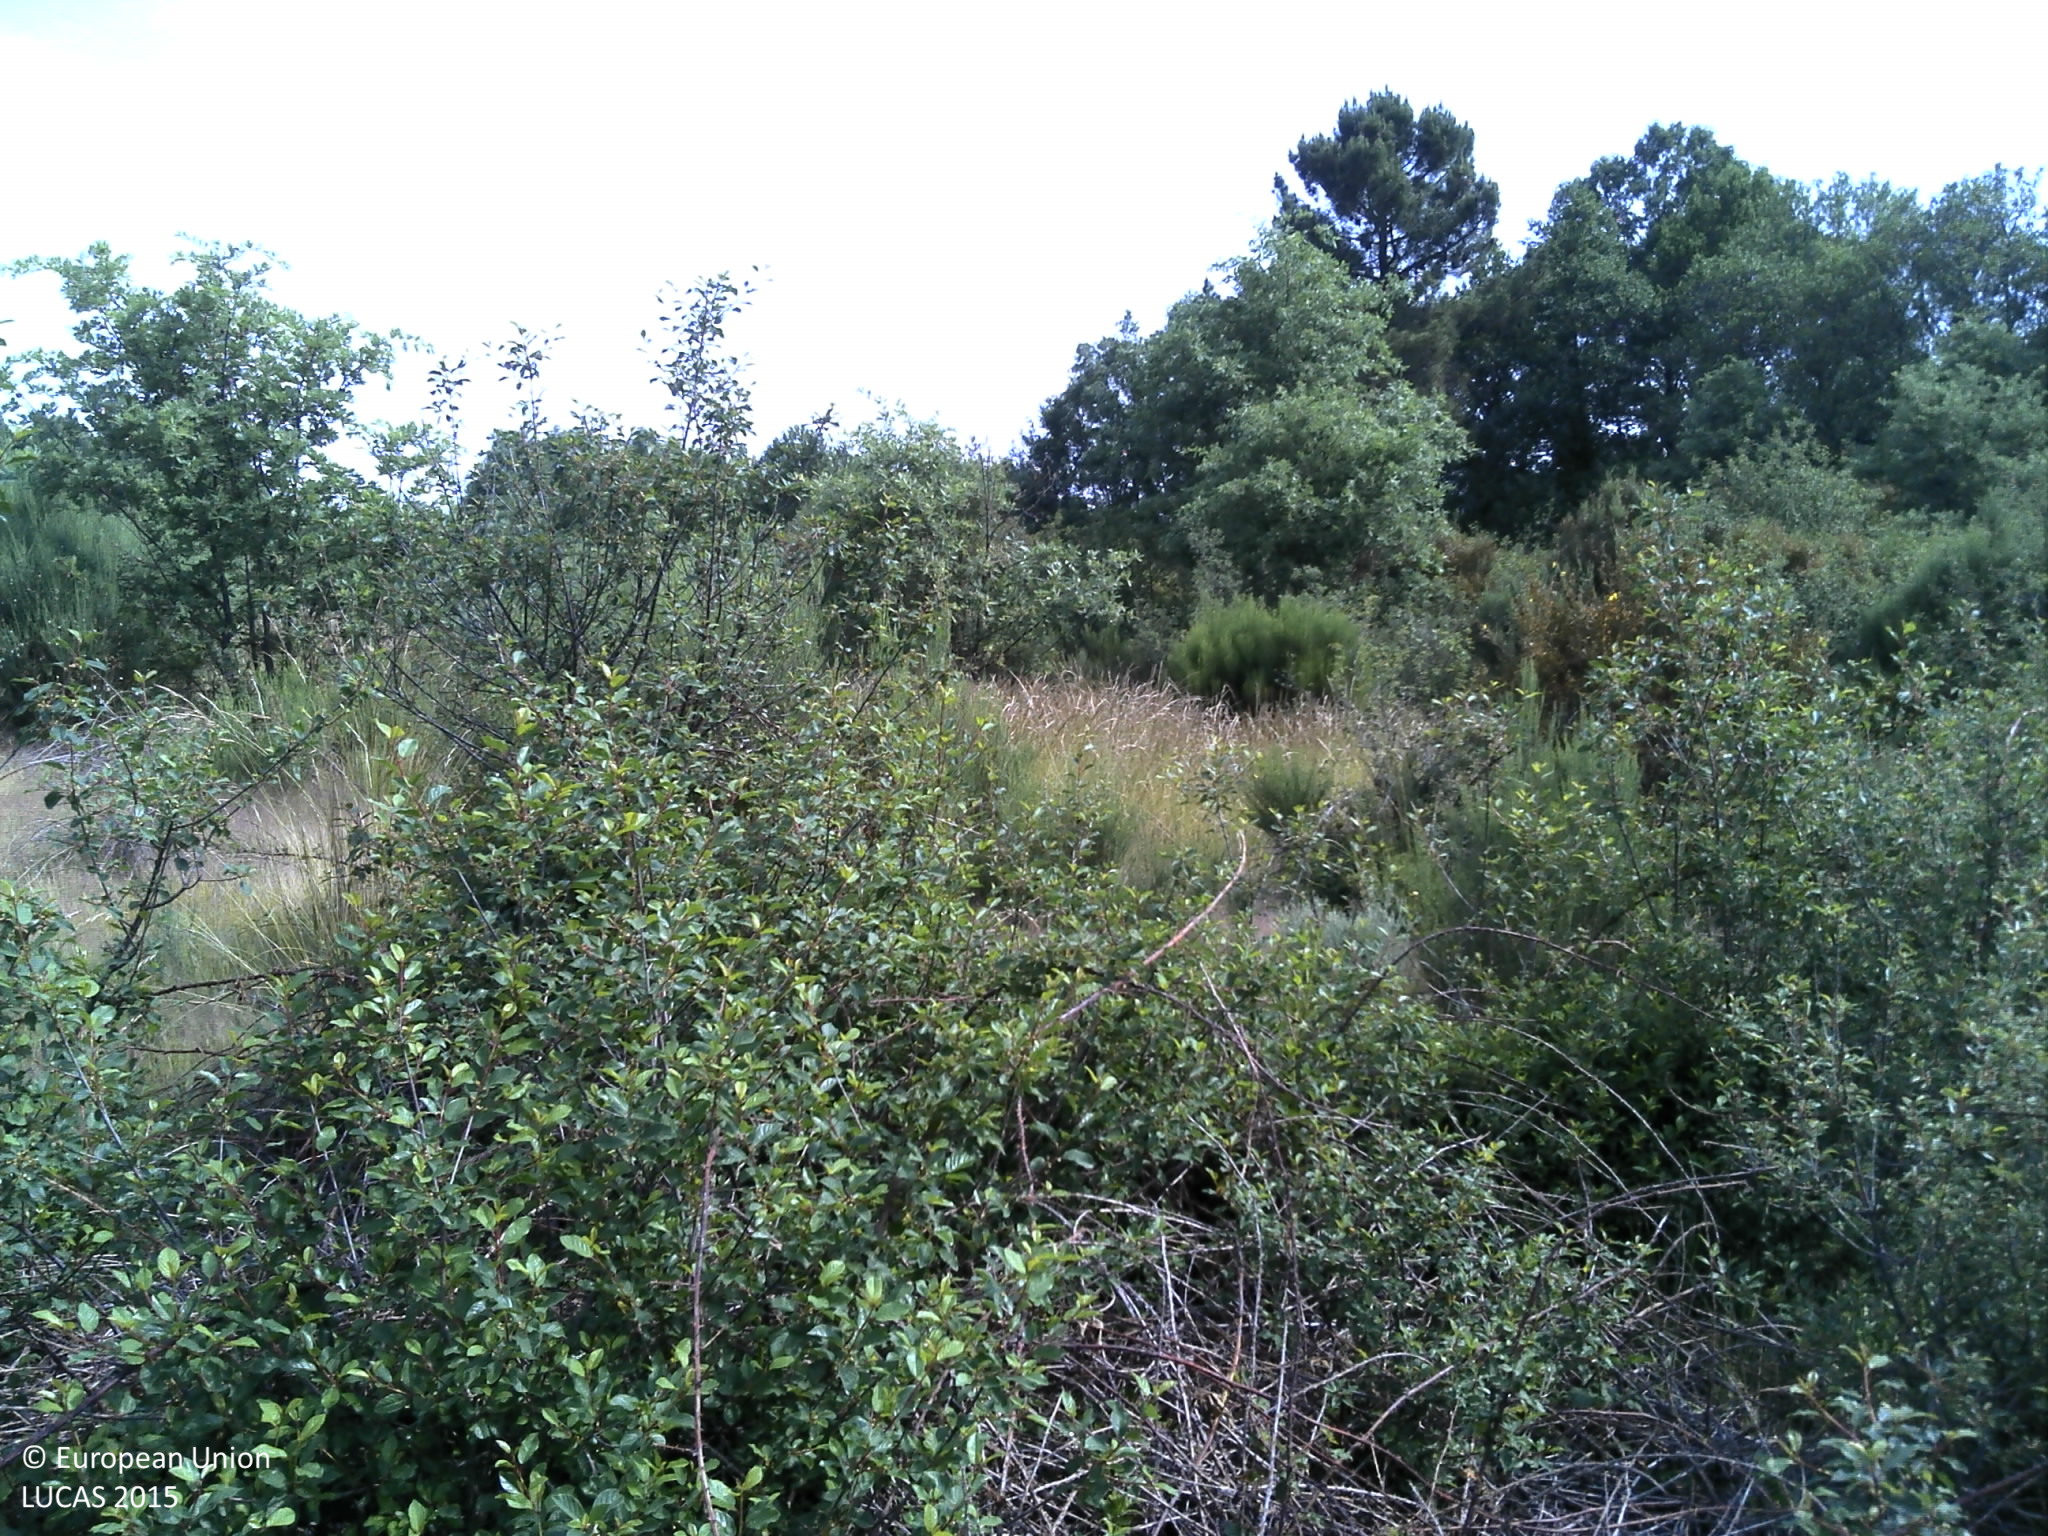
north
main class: Shrubland
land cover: Shrubland with sparse tree cover
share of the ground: > 75 %
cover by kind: shrubs 95 %, broadleaved forest trees 5 %
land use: Semi-natural and natural areas not in use
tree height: > 5 m
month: June
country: PT
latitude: 41.4409
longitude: -7.5417
